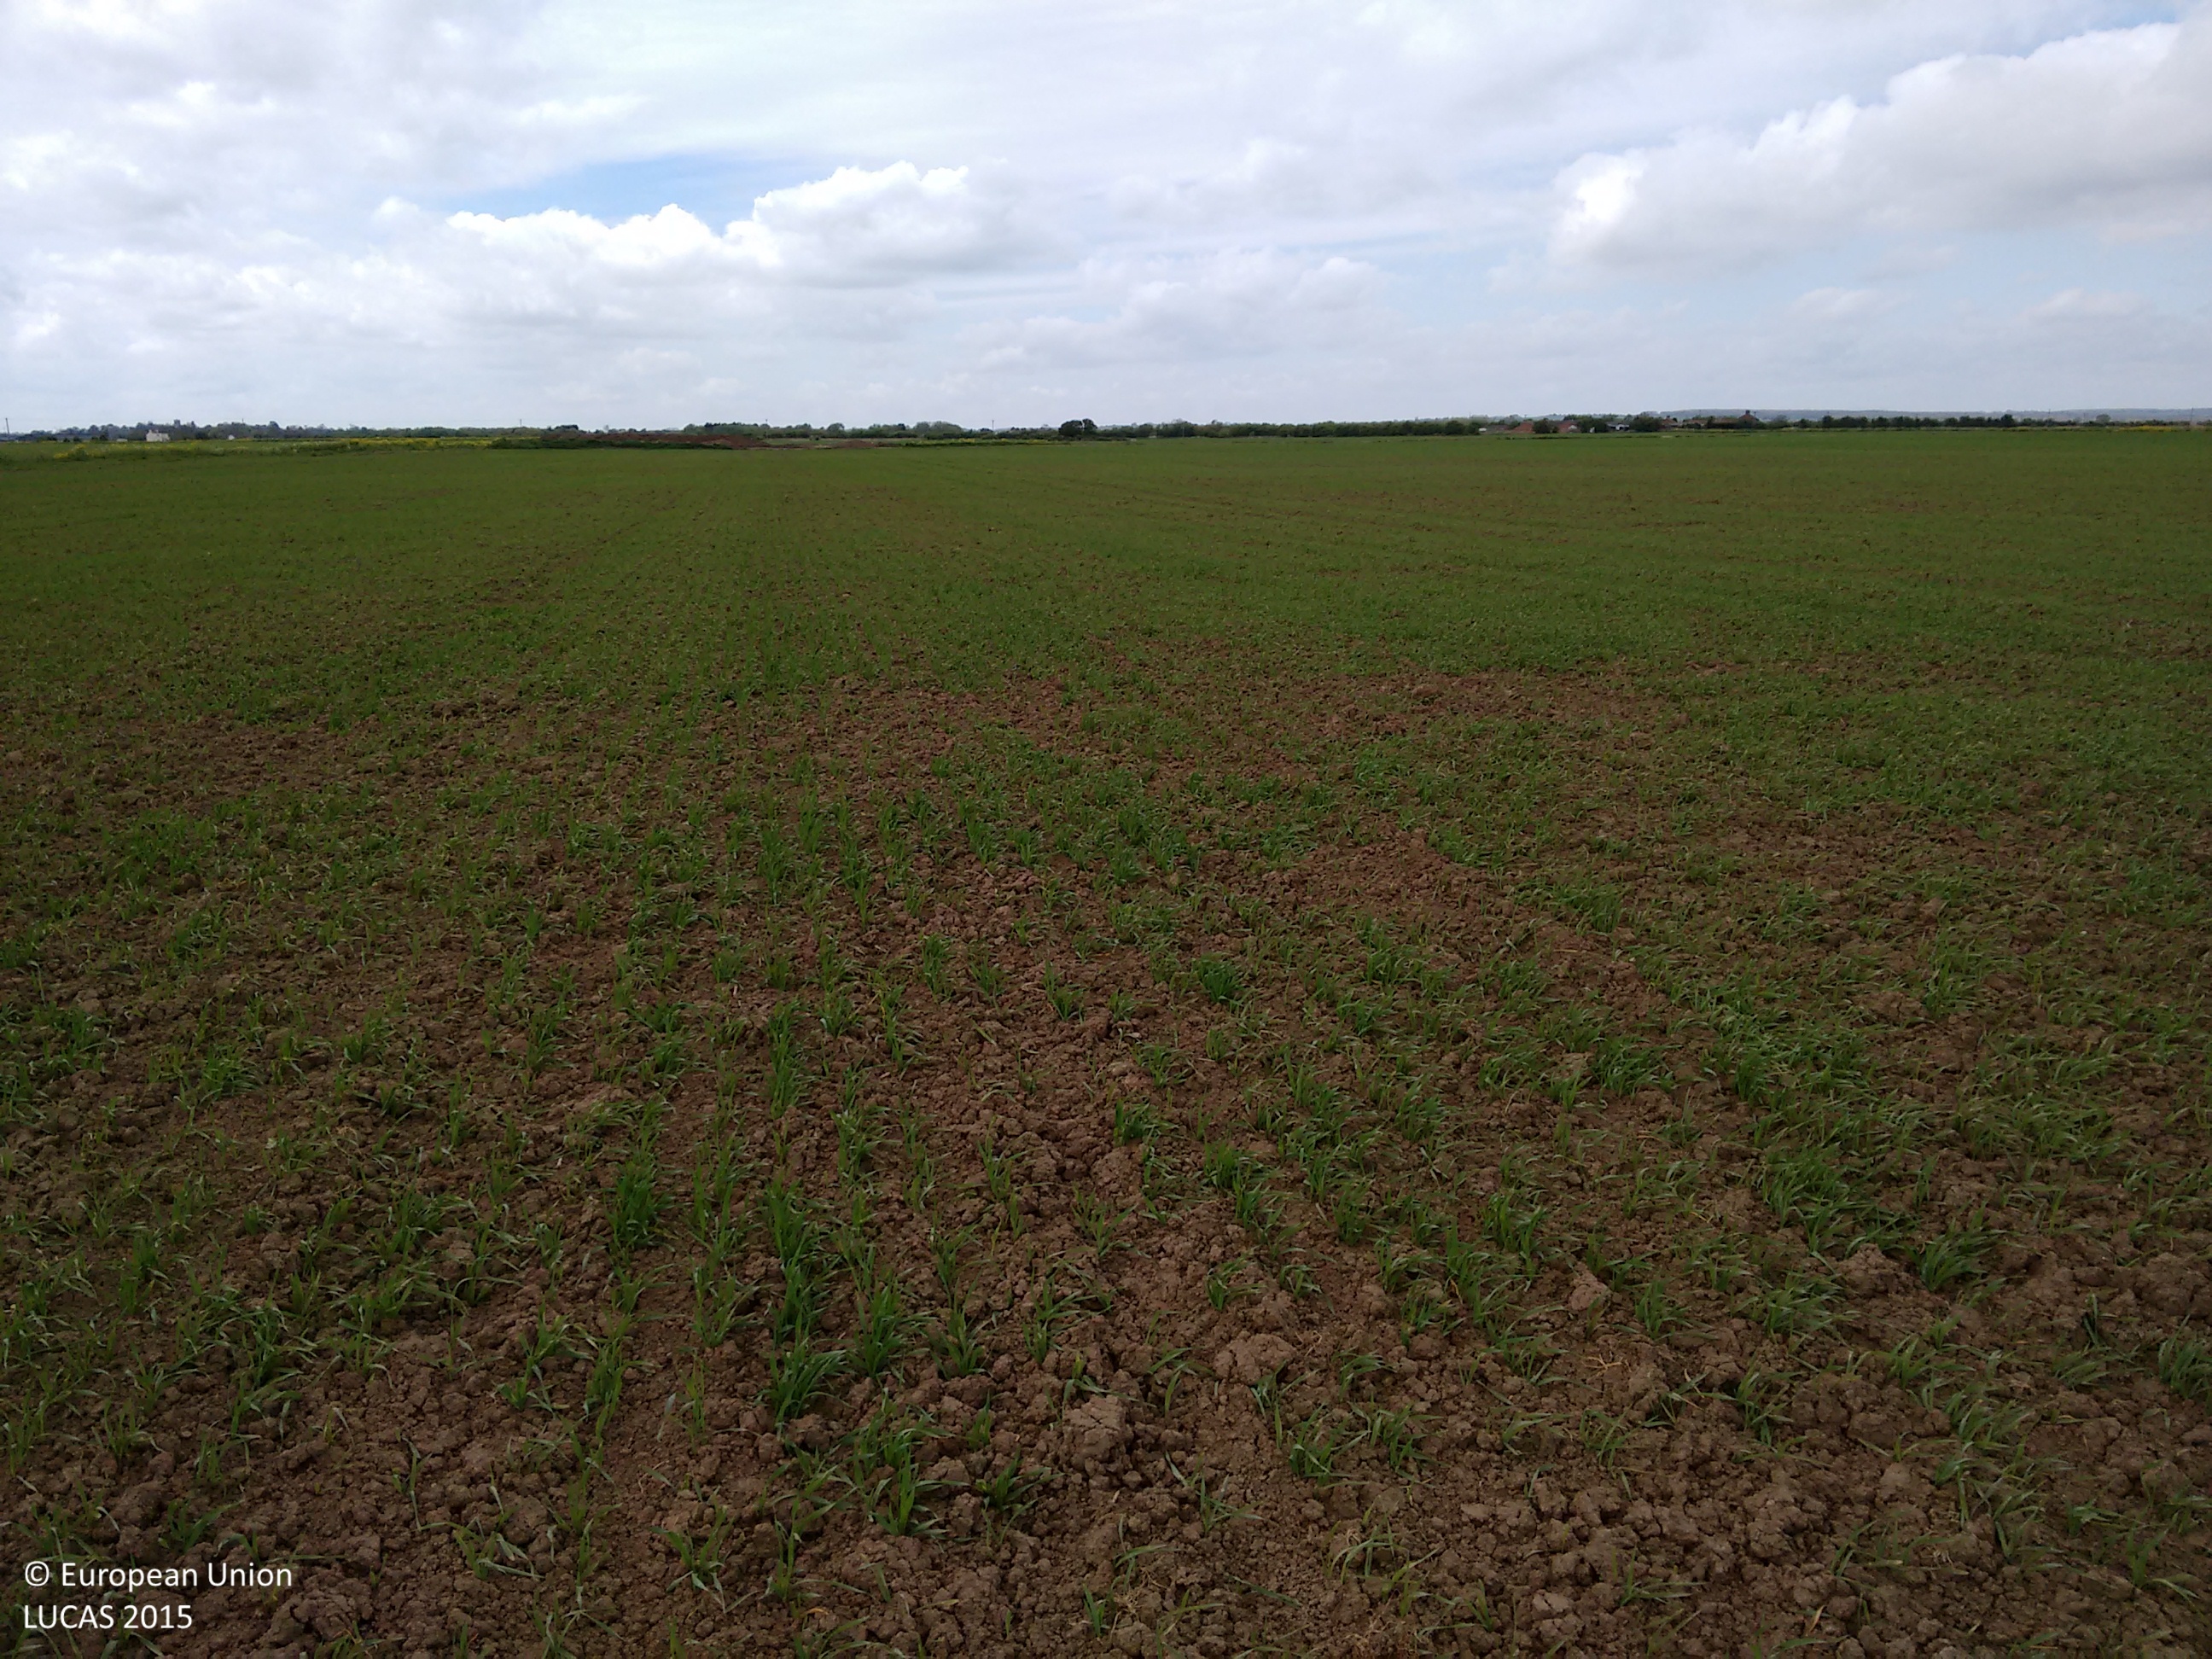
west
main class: Cropland
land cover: Barley
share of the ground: 10 - 25 %
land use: Agriculture (excluding fallow land and kitchen gardens)
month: May
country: GB
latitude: 53.1740
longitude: 0.2913
